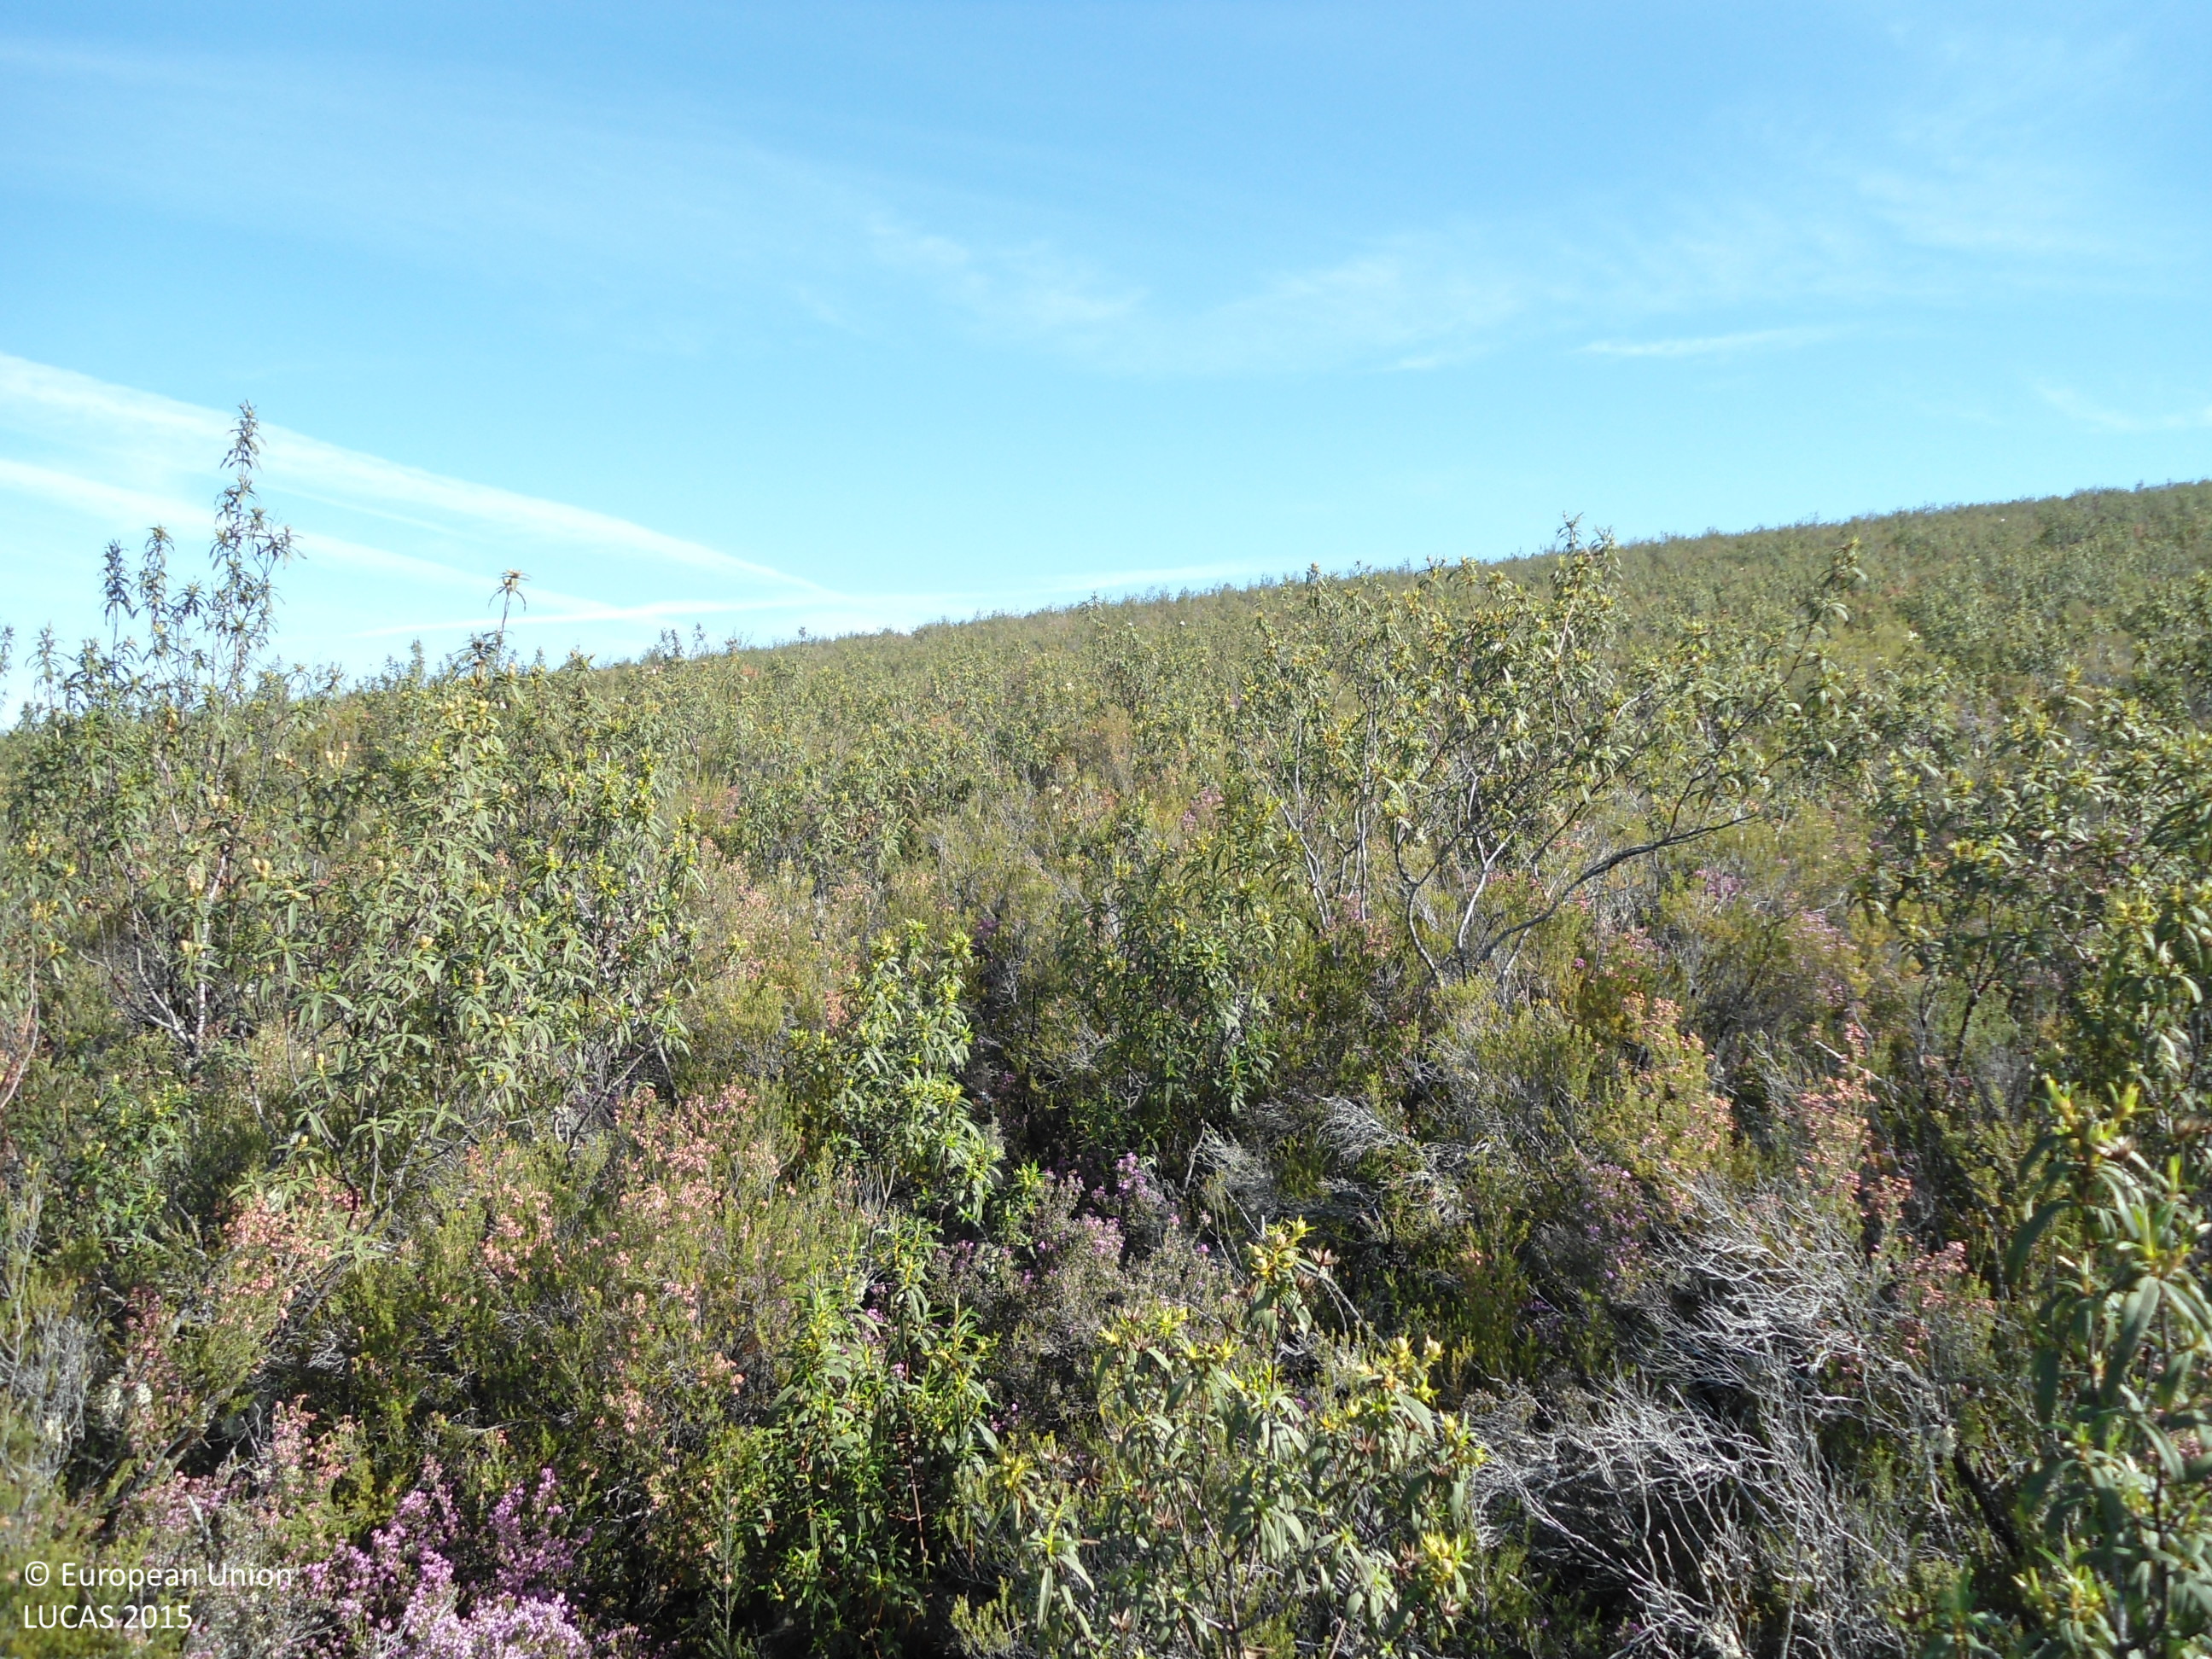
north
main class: Shrubland
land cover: Shrubland without tree cover
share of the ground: > 75 %
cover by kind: shrubs 100 %
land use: Semi-natural and natural areas not in use
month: April
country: ES
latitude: 41.7870
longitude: -6.1630
